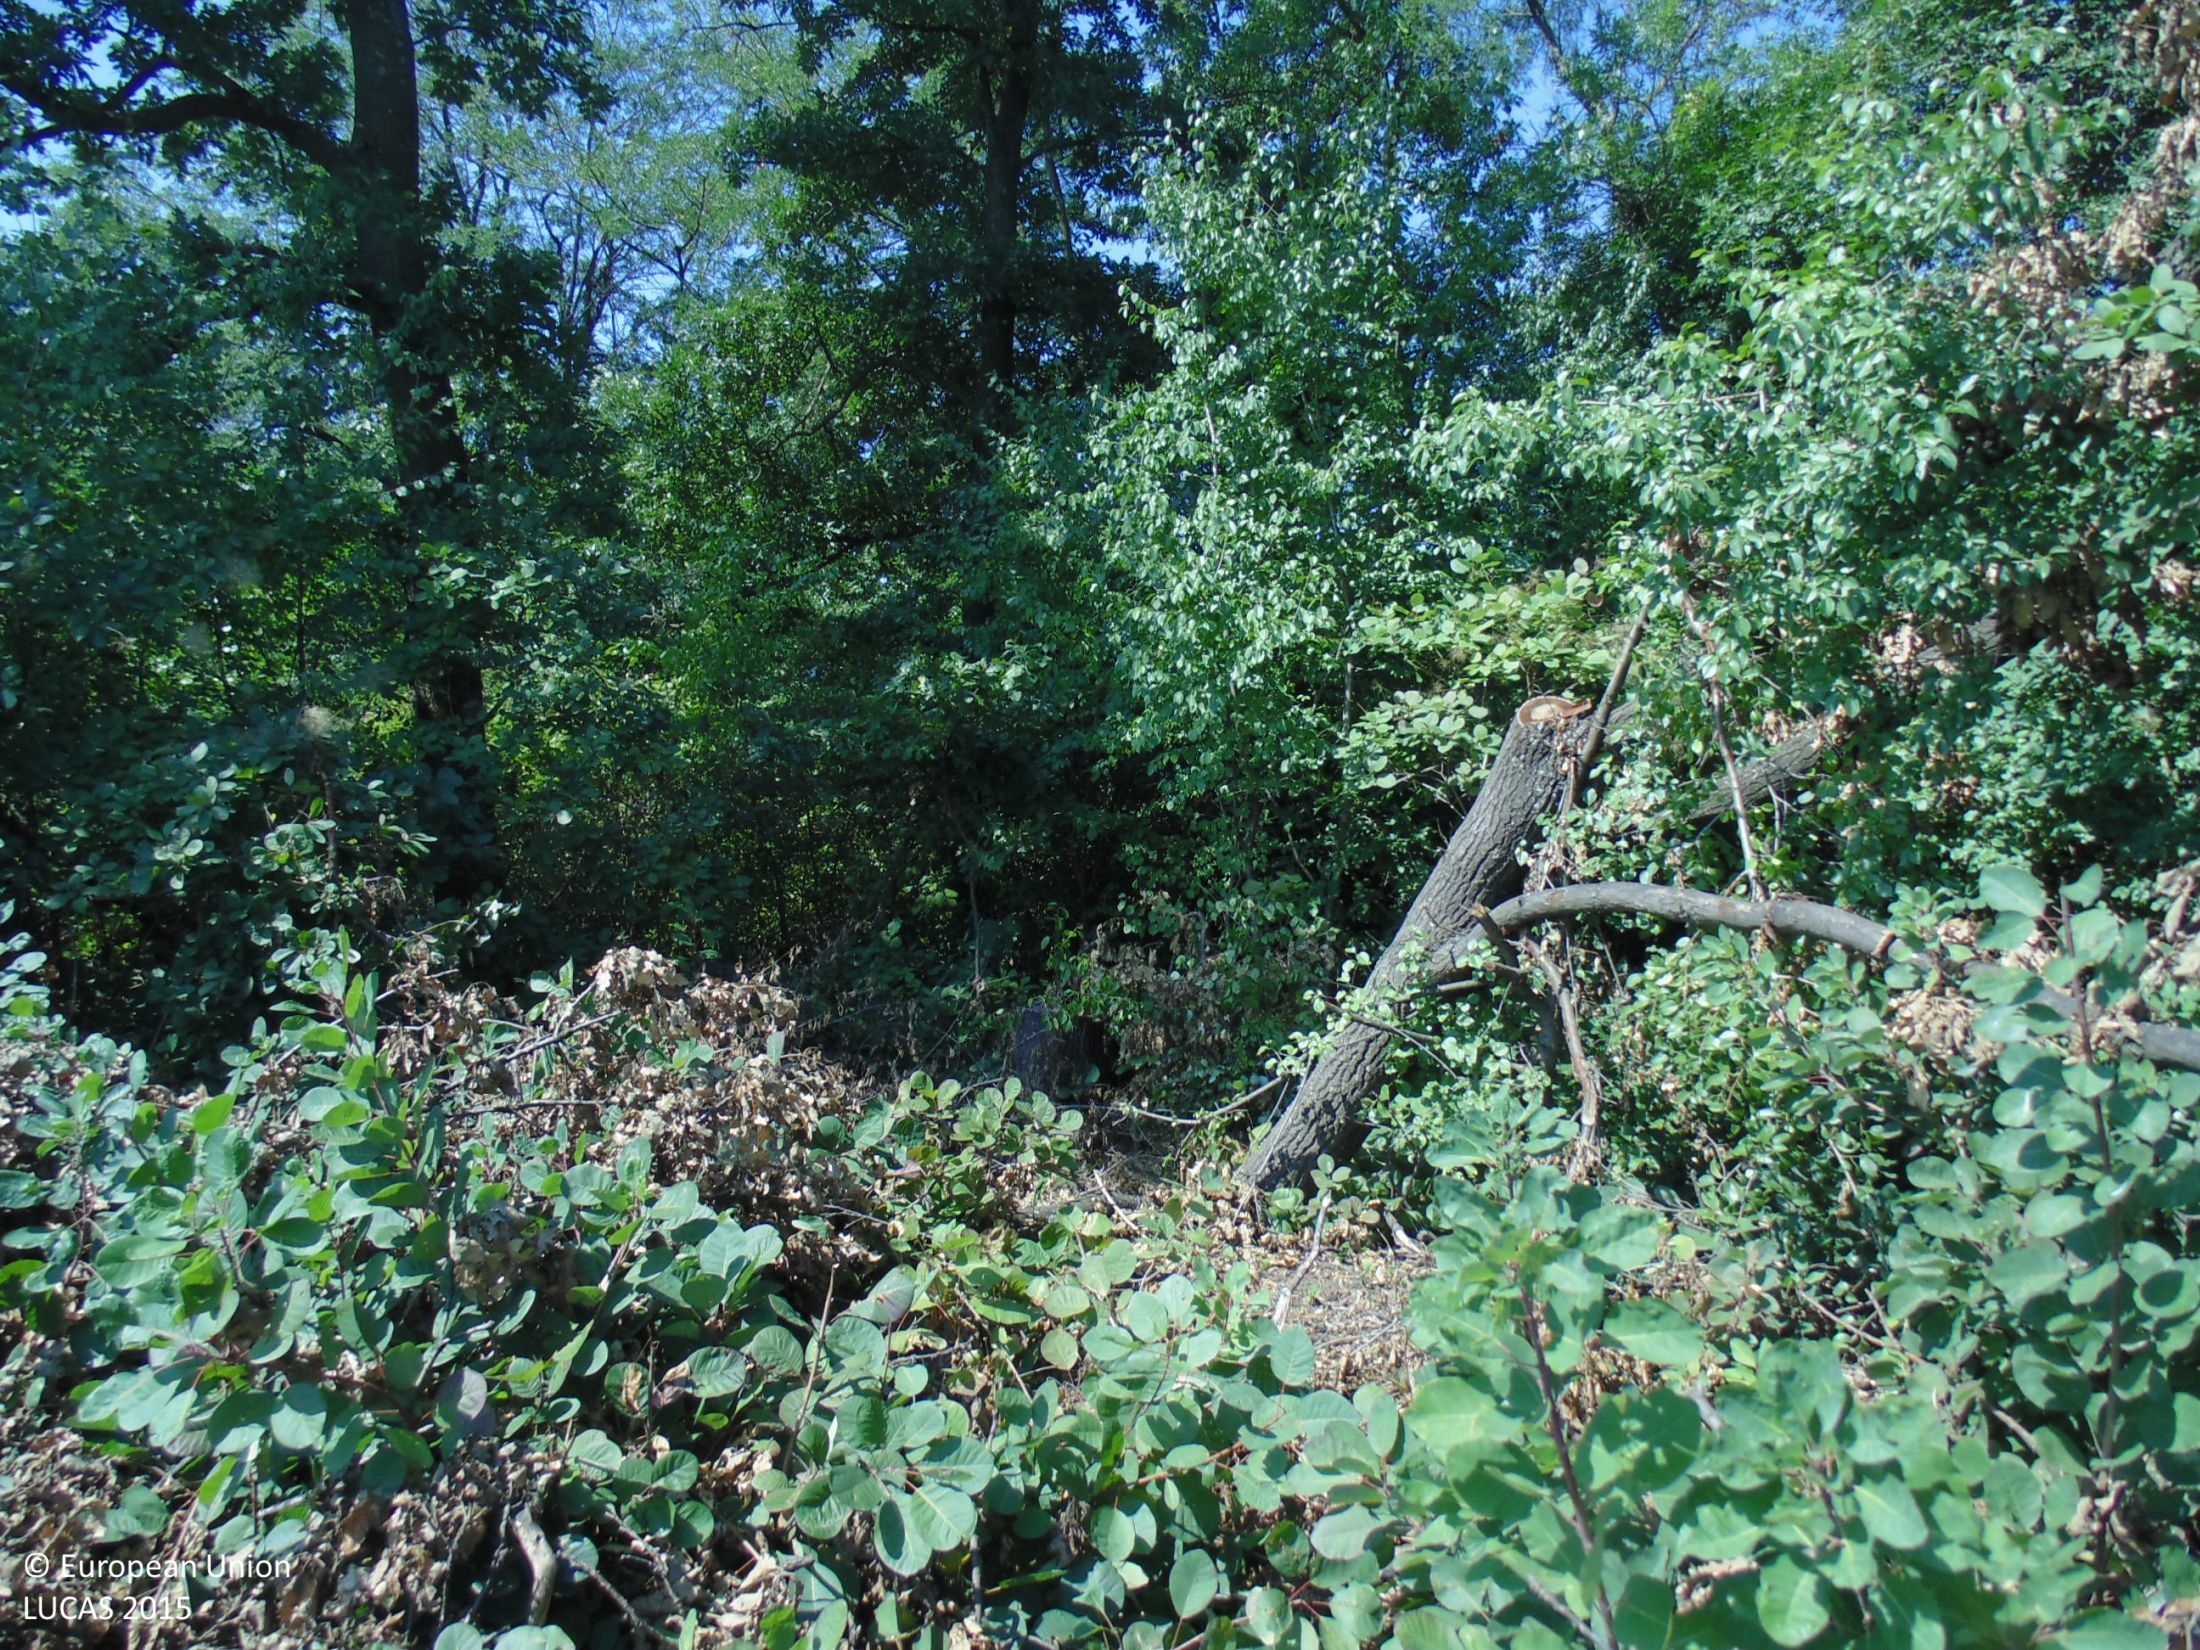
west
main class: Woodland
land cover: Broadleaved woodland
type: mesophytic deciduous forest
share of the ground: > 75 %
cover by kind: broadleaved forest trees 90 %, shrubs 5 %, unconsolidated bare surface 5 %
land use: Forestry
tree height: > 5 m
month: August
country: BG
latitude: 43.6364
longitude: 27.4222
